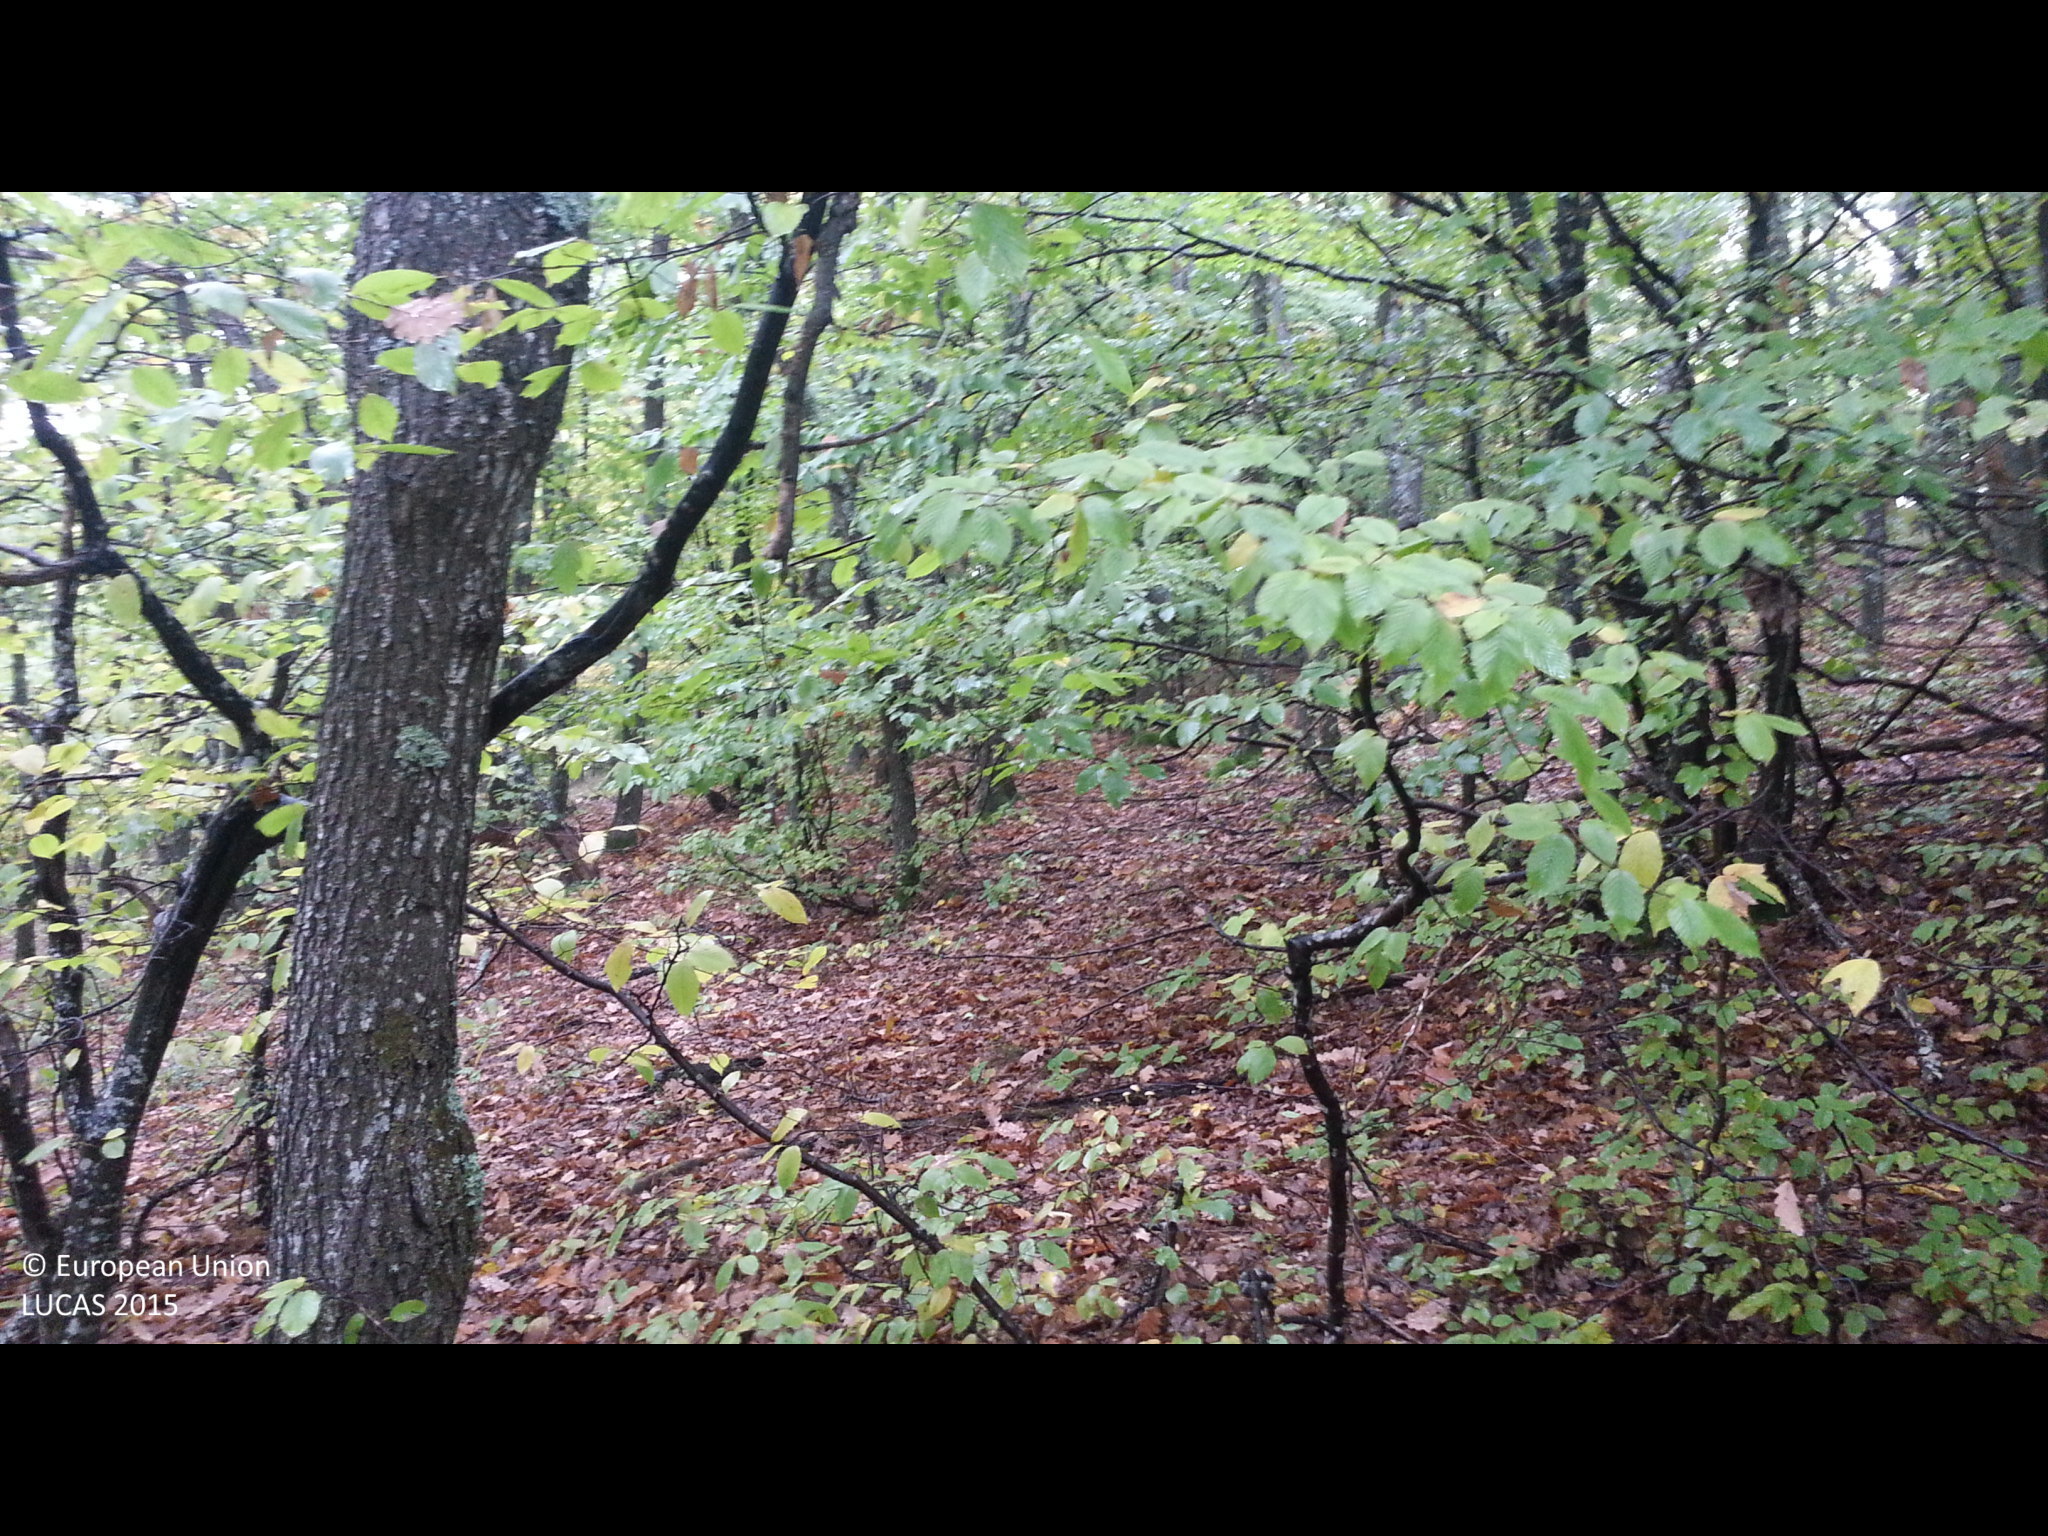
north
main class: Woodland
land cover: Broadleaved woodland
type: mesophytic deciduous forest
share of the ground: > 75 %
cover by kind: broadleaved forest trees 90 %, herbaceous plants 5 %, unconsolidated bare surface 5 %
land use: Forestry
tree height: > 5 m
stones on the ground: < 10 %
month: October
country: BG
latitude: 42.7432
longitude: 22.7189
